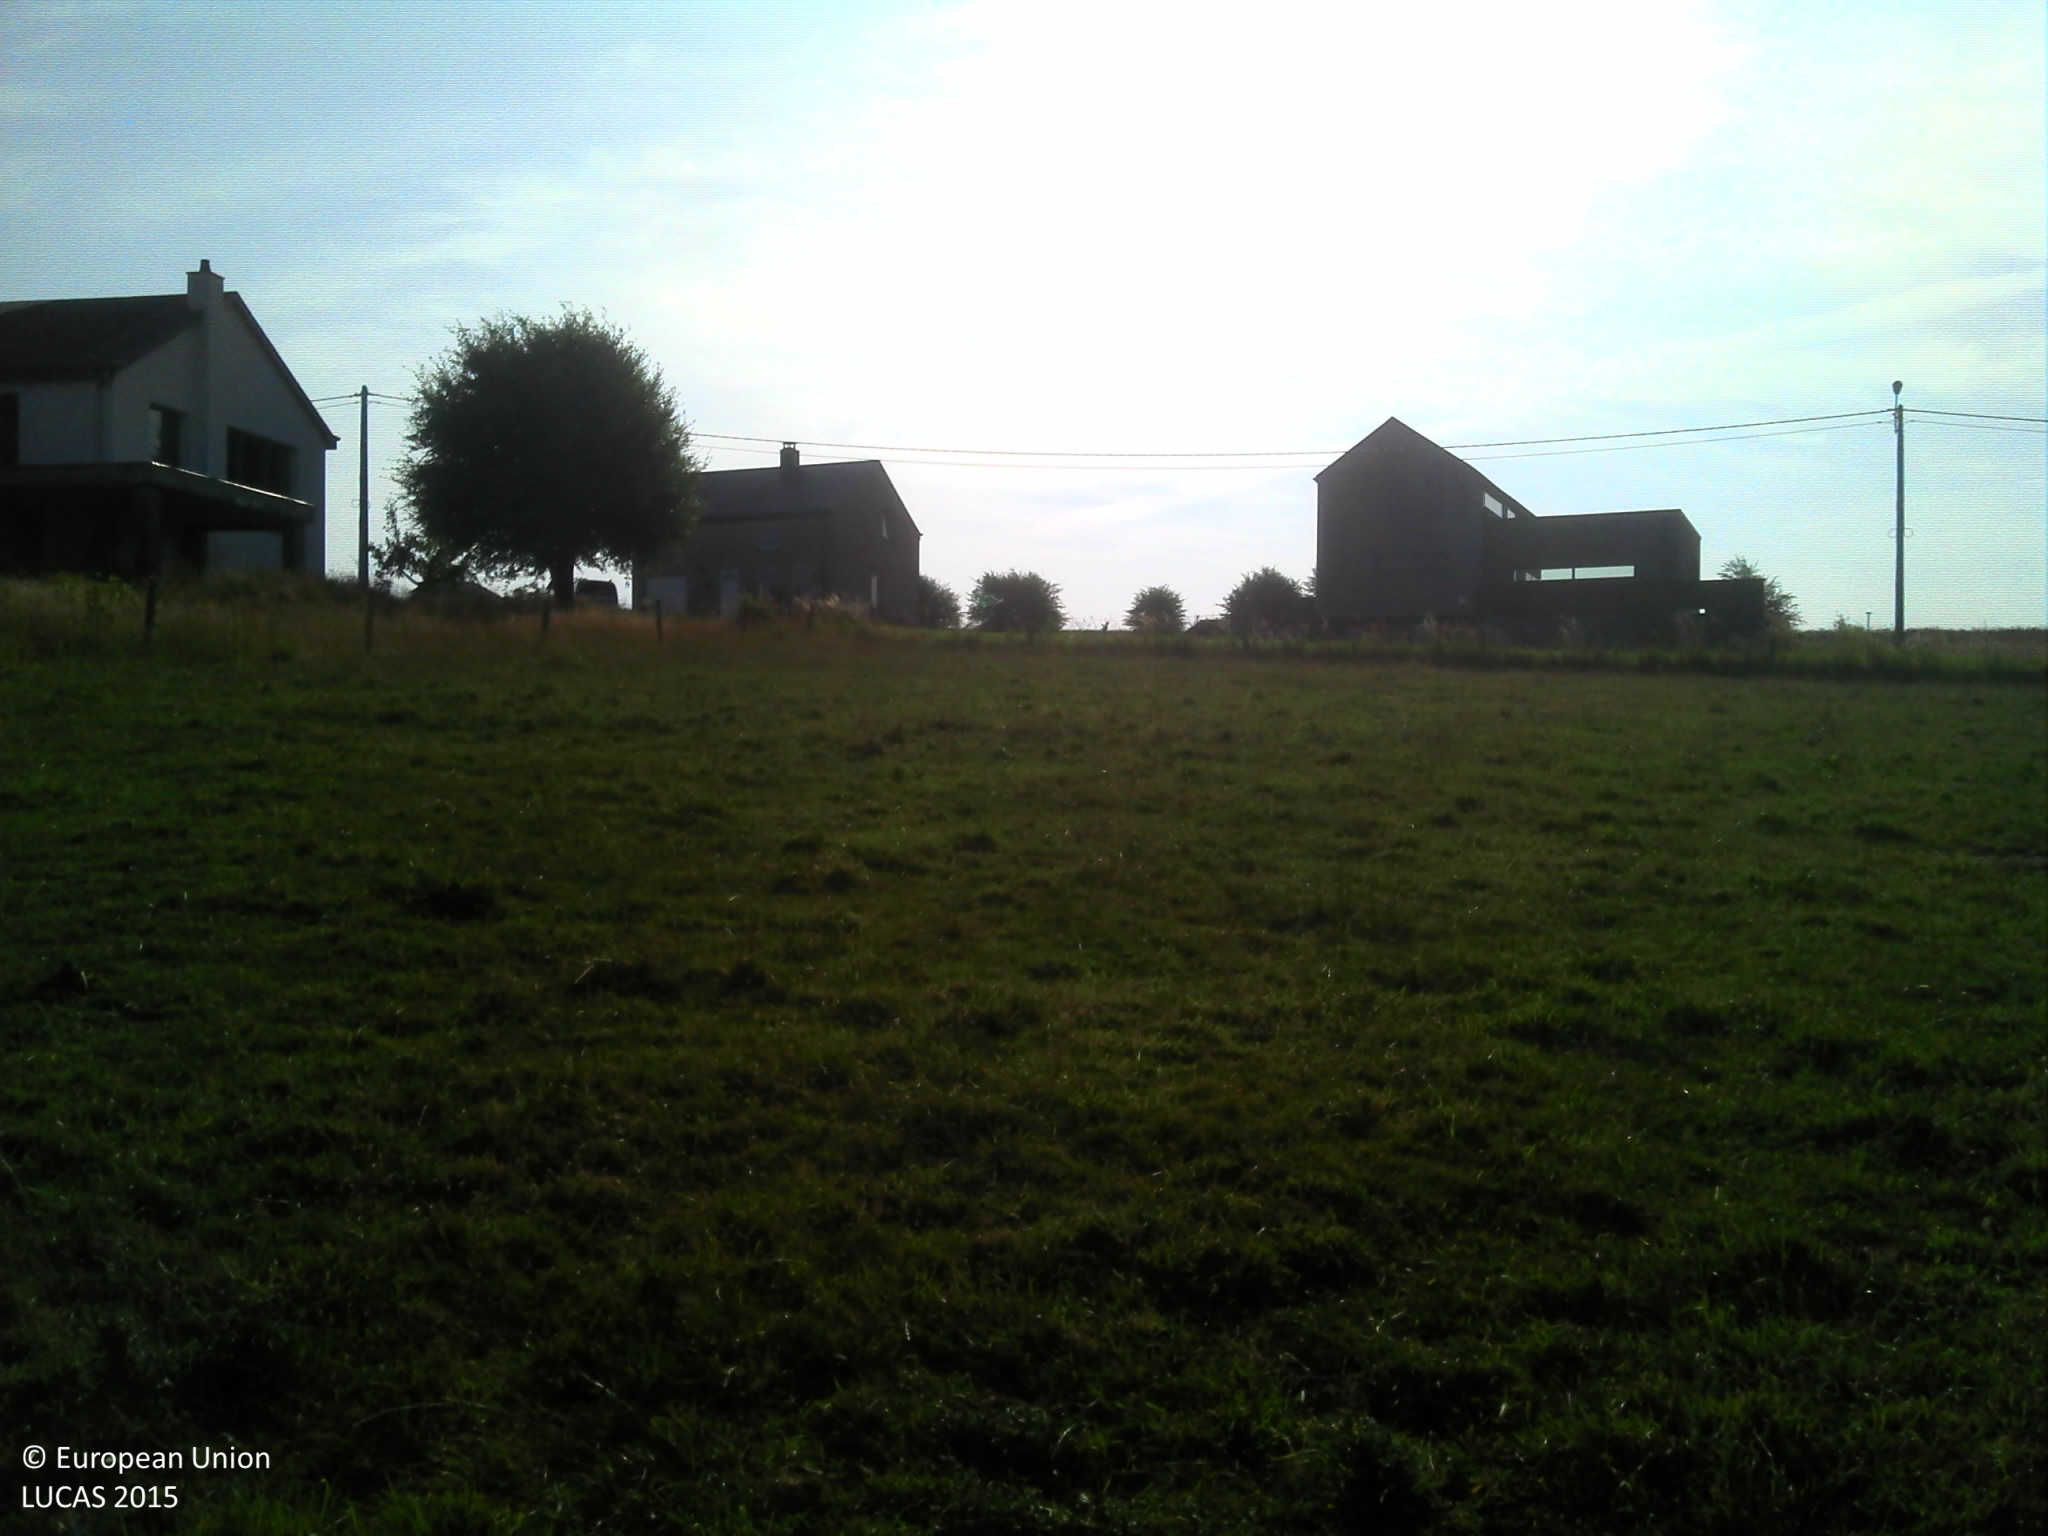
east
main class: Grassland
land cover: Grassland without tree/shrub cover
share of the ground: > 75 %
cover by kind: herbaceous plants 100 %
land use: Agriculture (excluding fallow land and kitchen gardens)
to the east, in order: Grassland without tree/shrub cover; Artificial constructions in urban areas; Common wheat; Fences; Grassland without tree/shrub cover
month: July
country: BE
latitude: 49.9545
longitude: 5.5802
